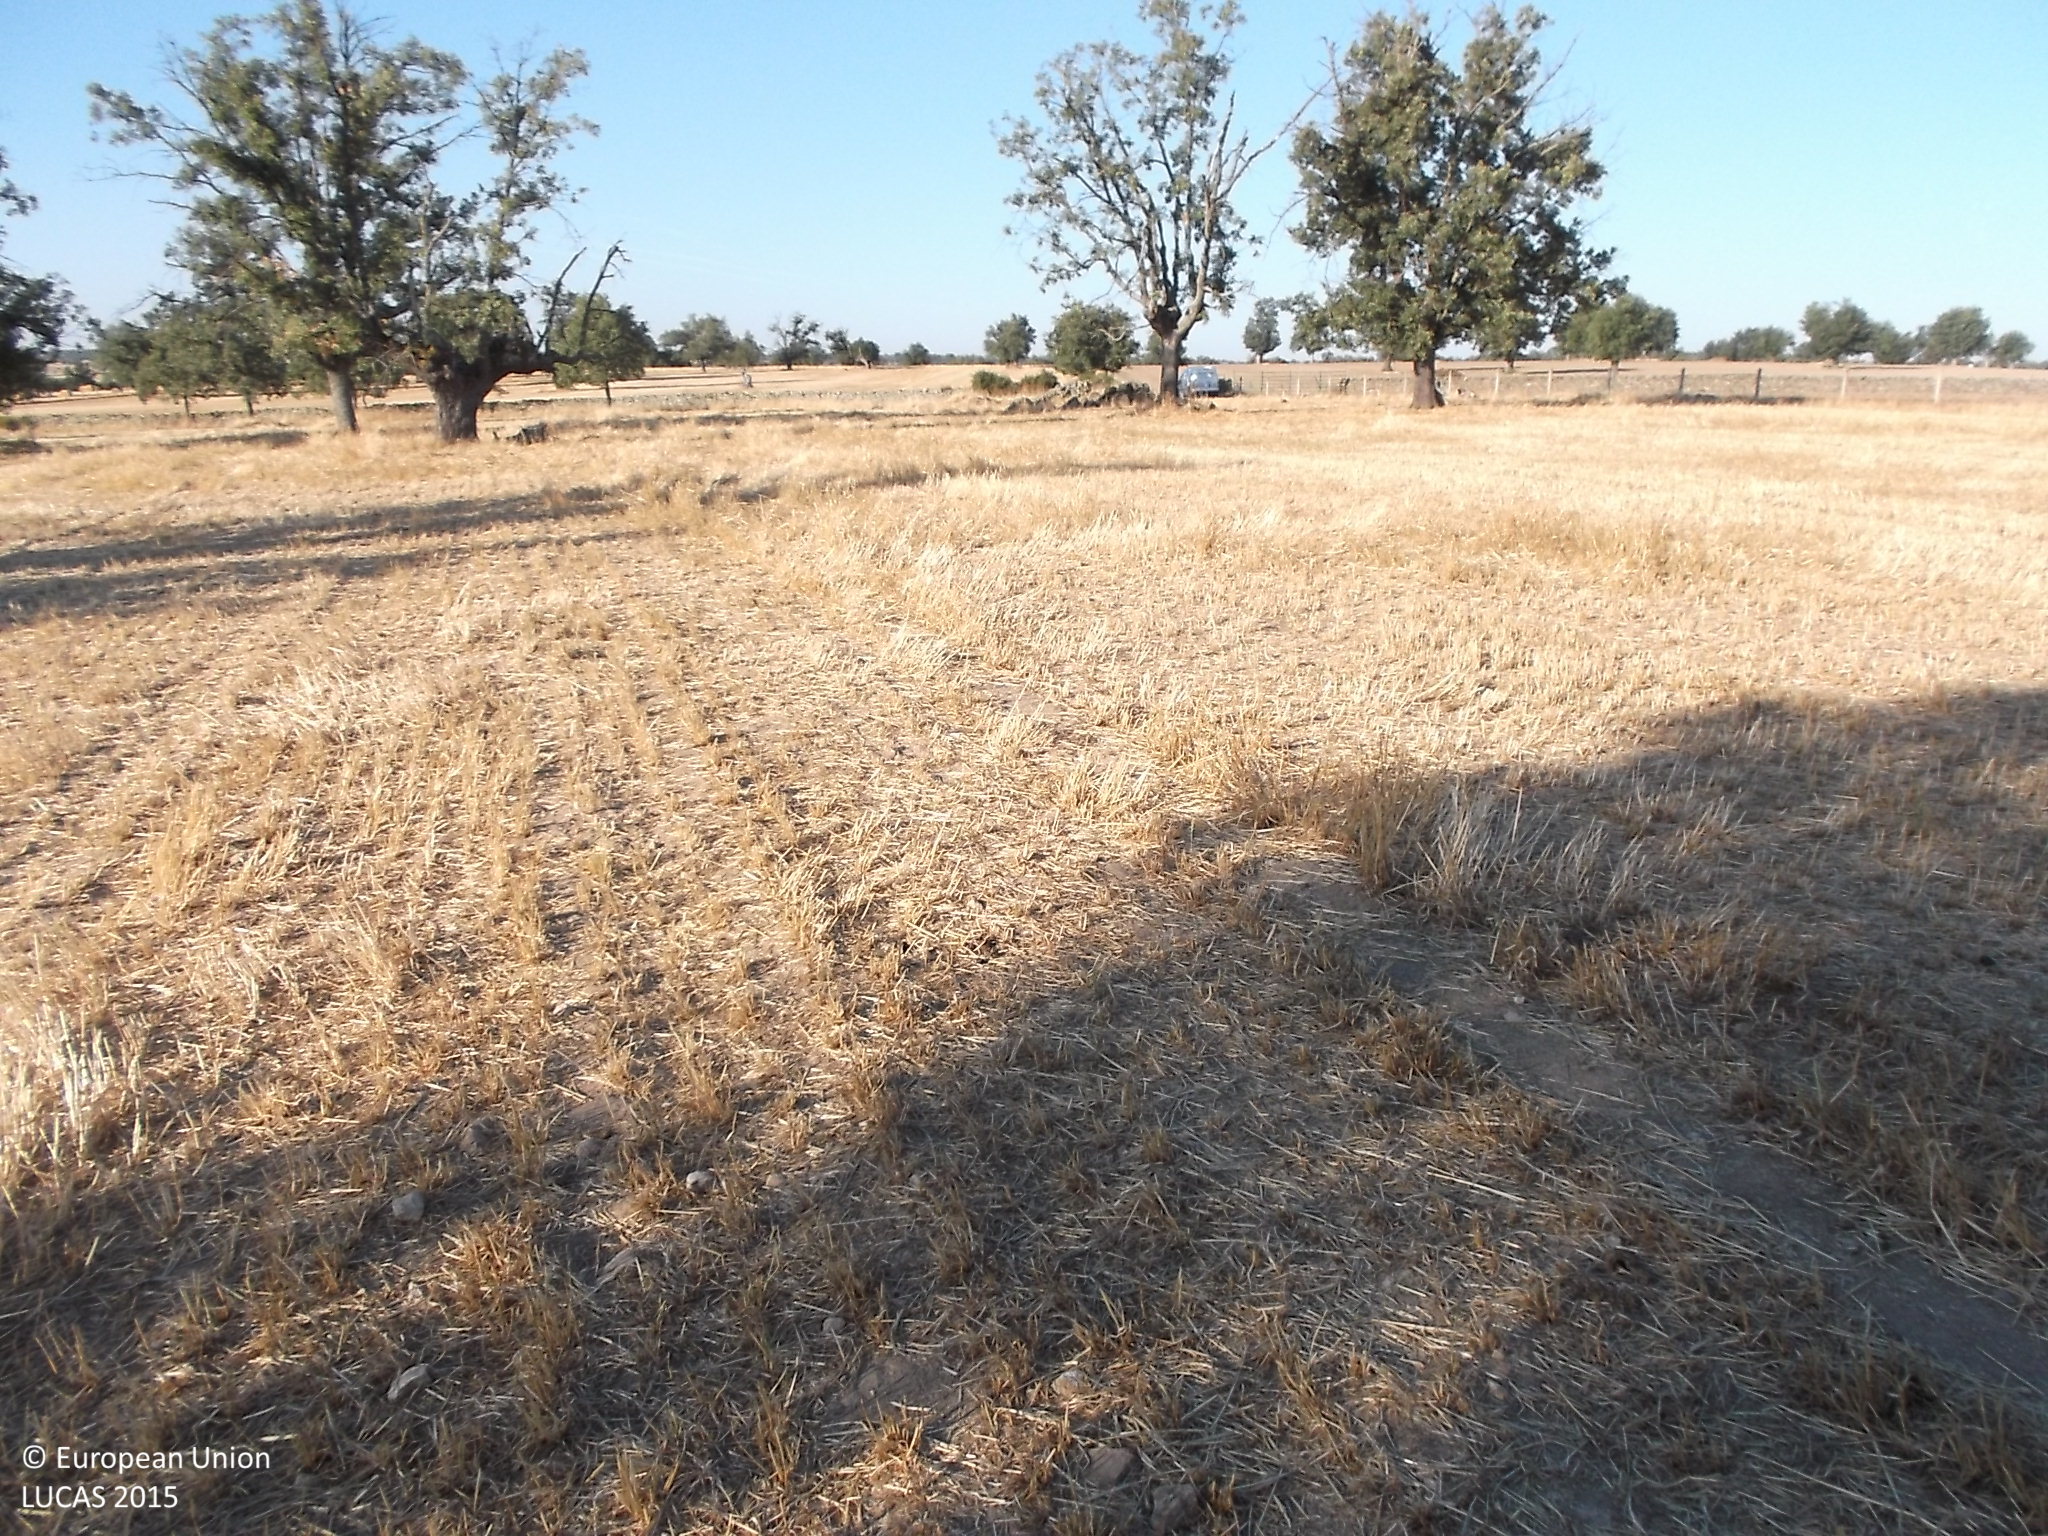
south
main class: Cropland
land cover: Mixed cereals for fodder
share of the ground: < 10 %
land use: Agriculture (excluding fallow land and kitchen gardens)
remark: Harvested field
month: July
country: ES
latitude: 41.1069
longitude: -6.4937
